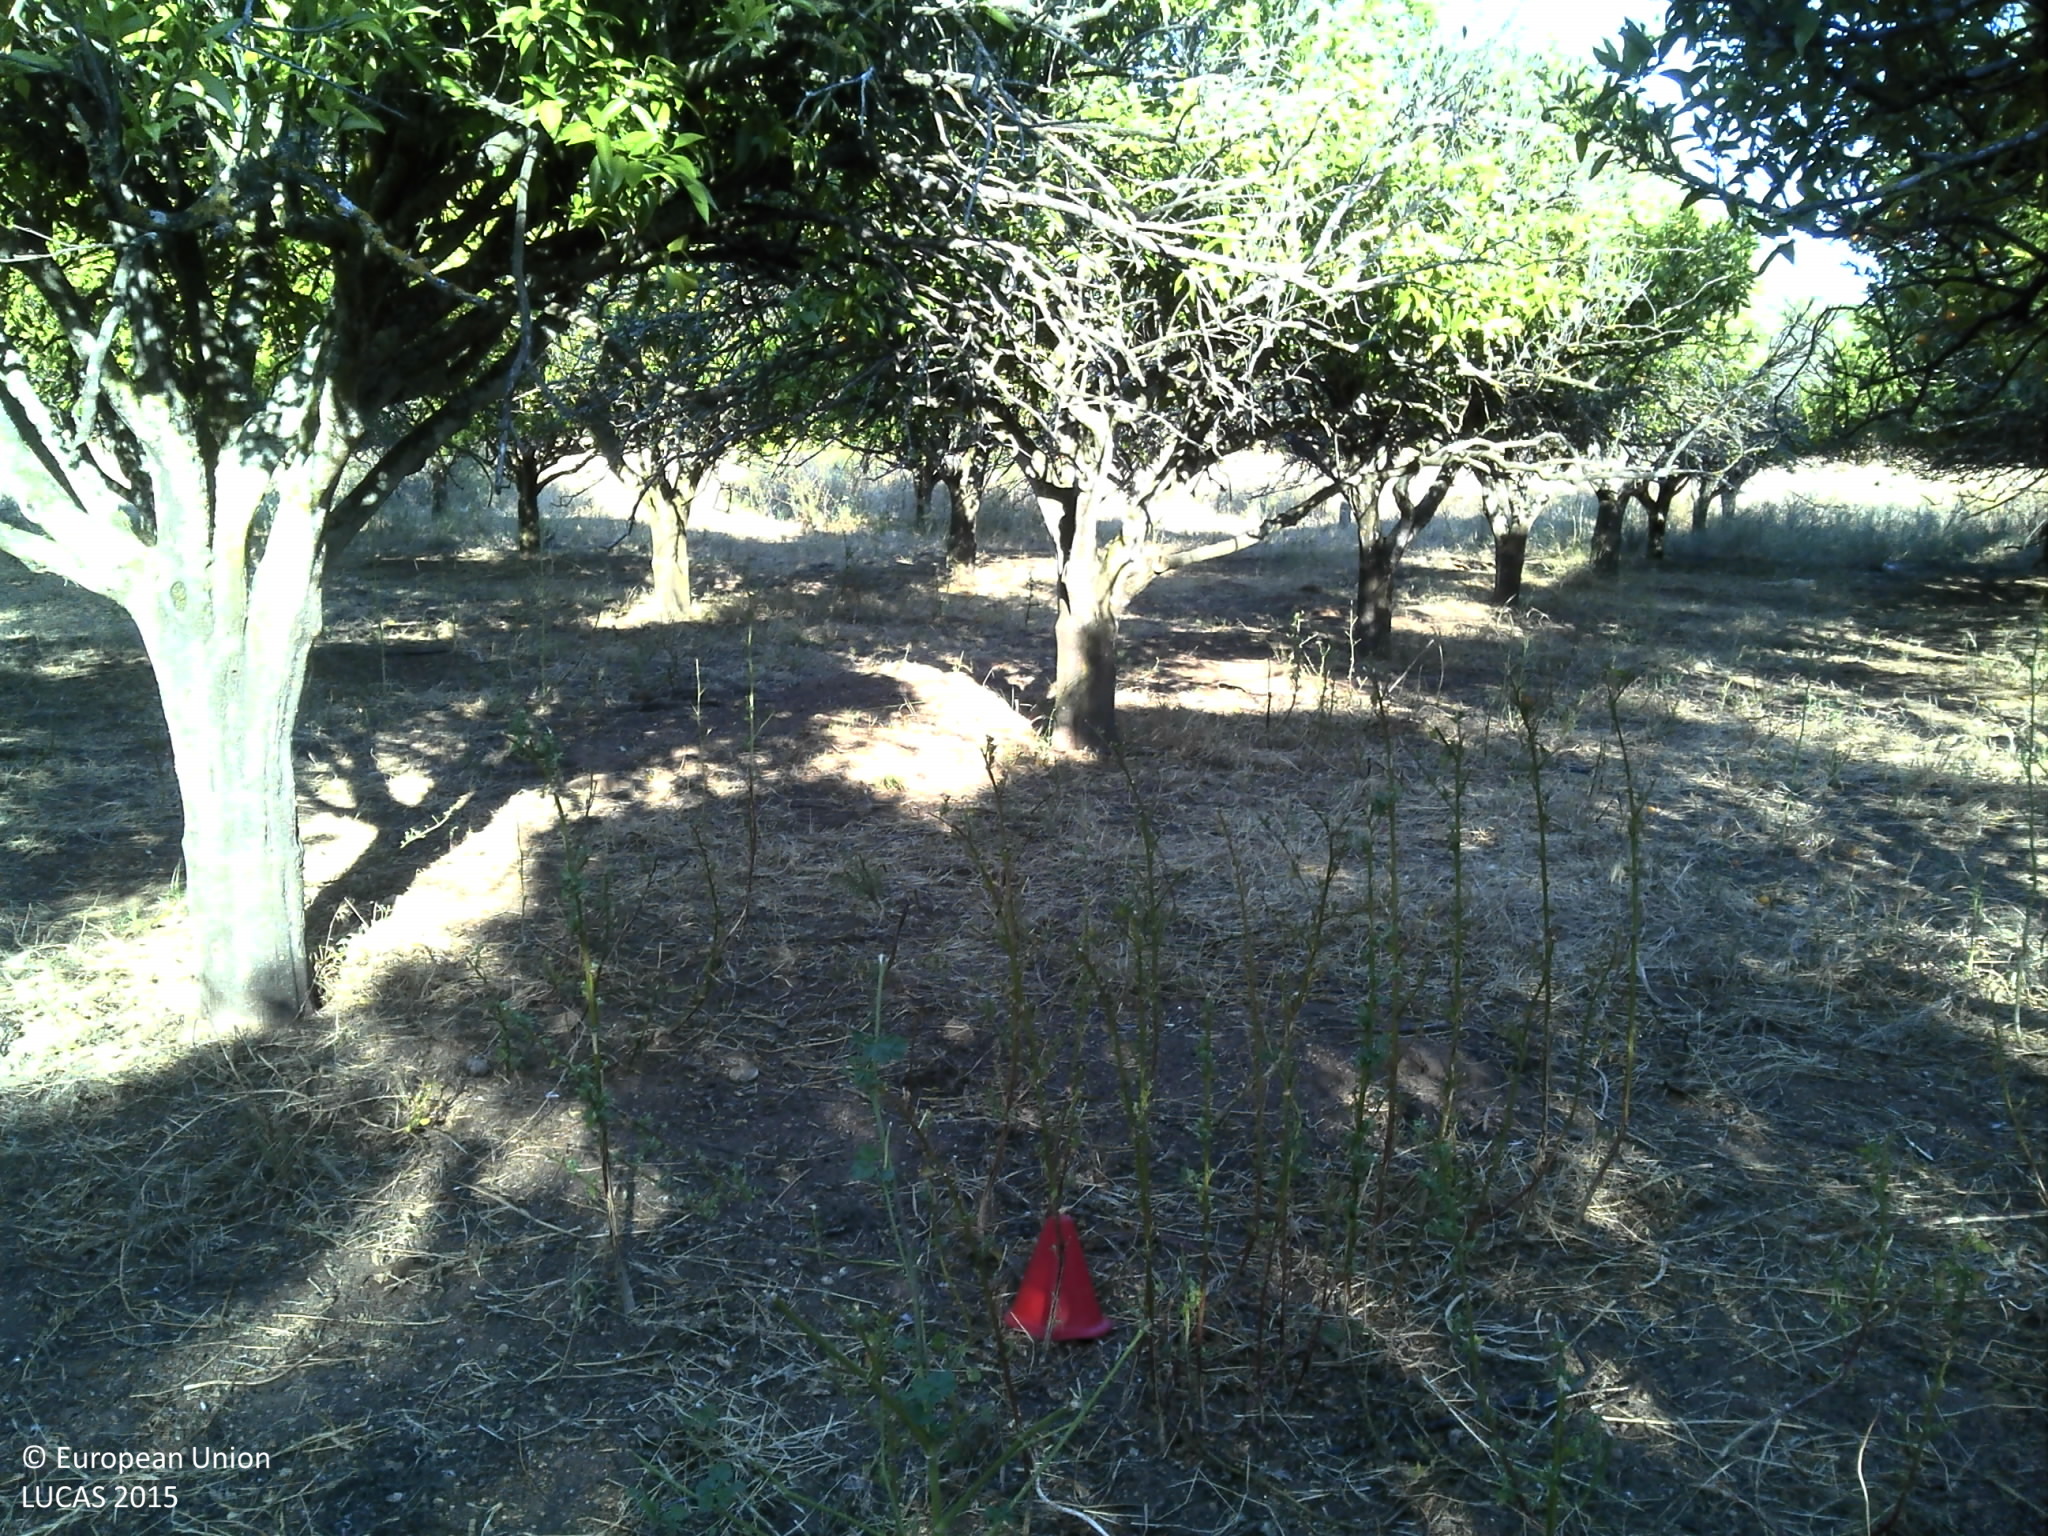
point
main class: Cropland
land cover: Other citrus fruit
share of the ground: > 75 %
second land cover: Grassland without tree/shrub cover
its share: < 10 %
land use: Abandoned areas
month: May
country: PT
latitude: 37.1846
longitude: -7.4962
